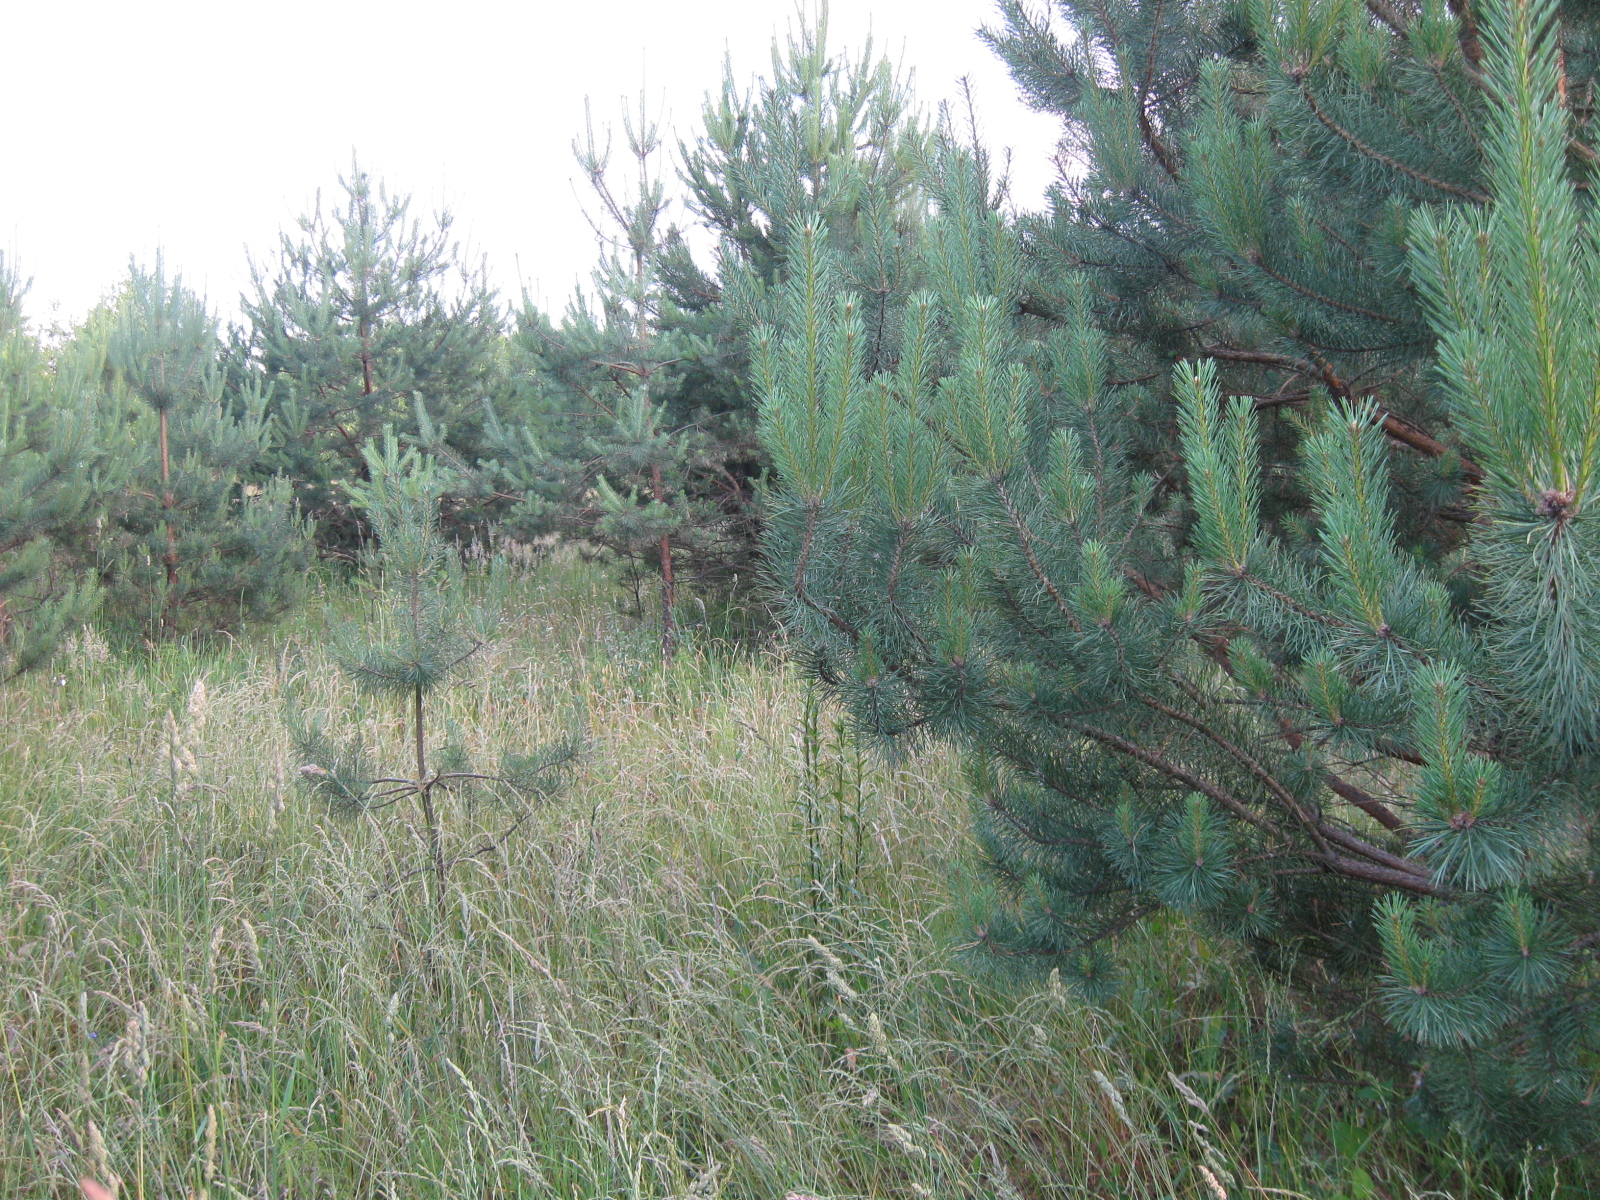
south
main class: Woodland
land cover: Pine dominated coniferous woodland
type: hemiboreal forest and nemoral coniferous forest and mixed broadleaved-coniferous forest
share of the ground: 50 - 75 %
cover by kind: coniferous forest trees 60 %, herbaceous plants 40 %
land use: Forestry
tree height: < 5 m
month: June
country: LT
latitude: 54.2021
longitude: 24.2163
